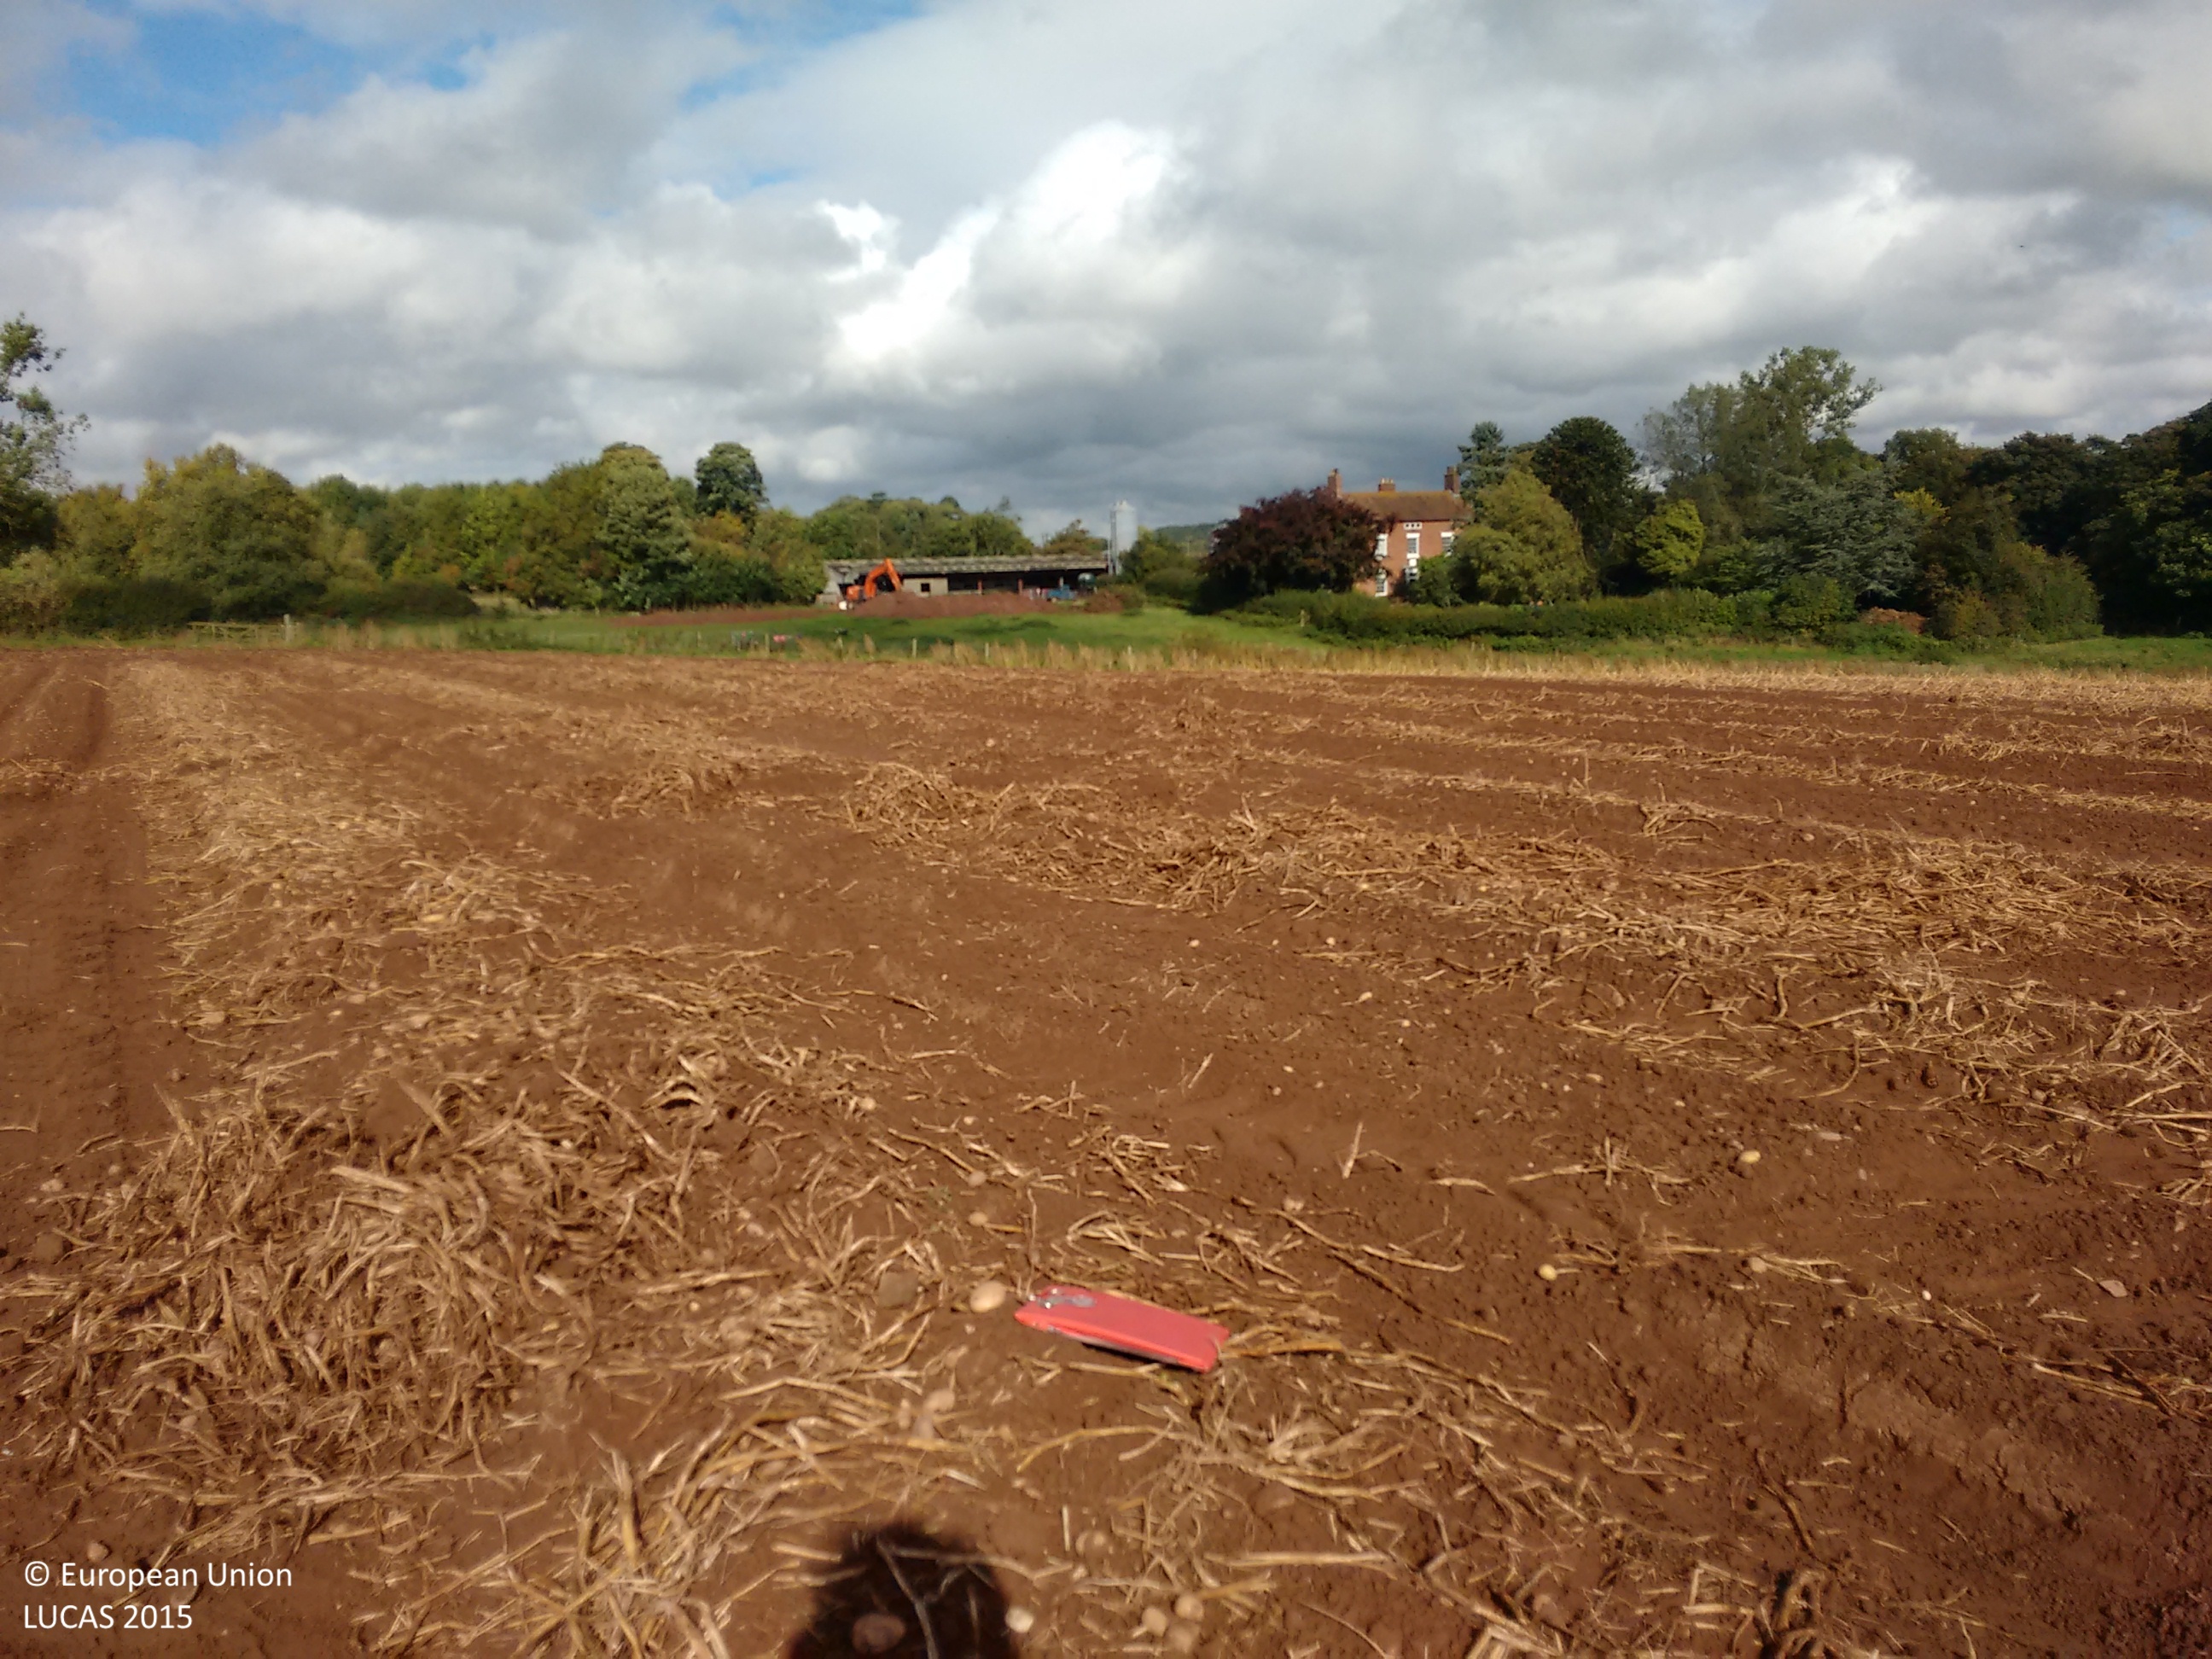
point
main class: Cropland
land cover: Potatoes
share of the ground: < 10 %
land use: Agriculture (excluding fallow land and kitchen gardens)
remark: Harvested field
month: October
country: GB
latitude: 52.7107
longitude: -2.3642
